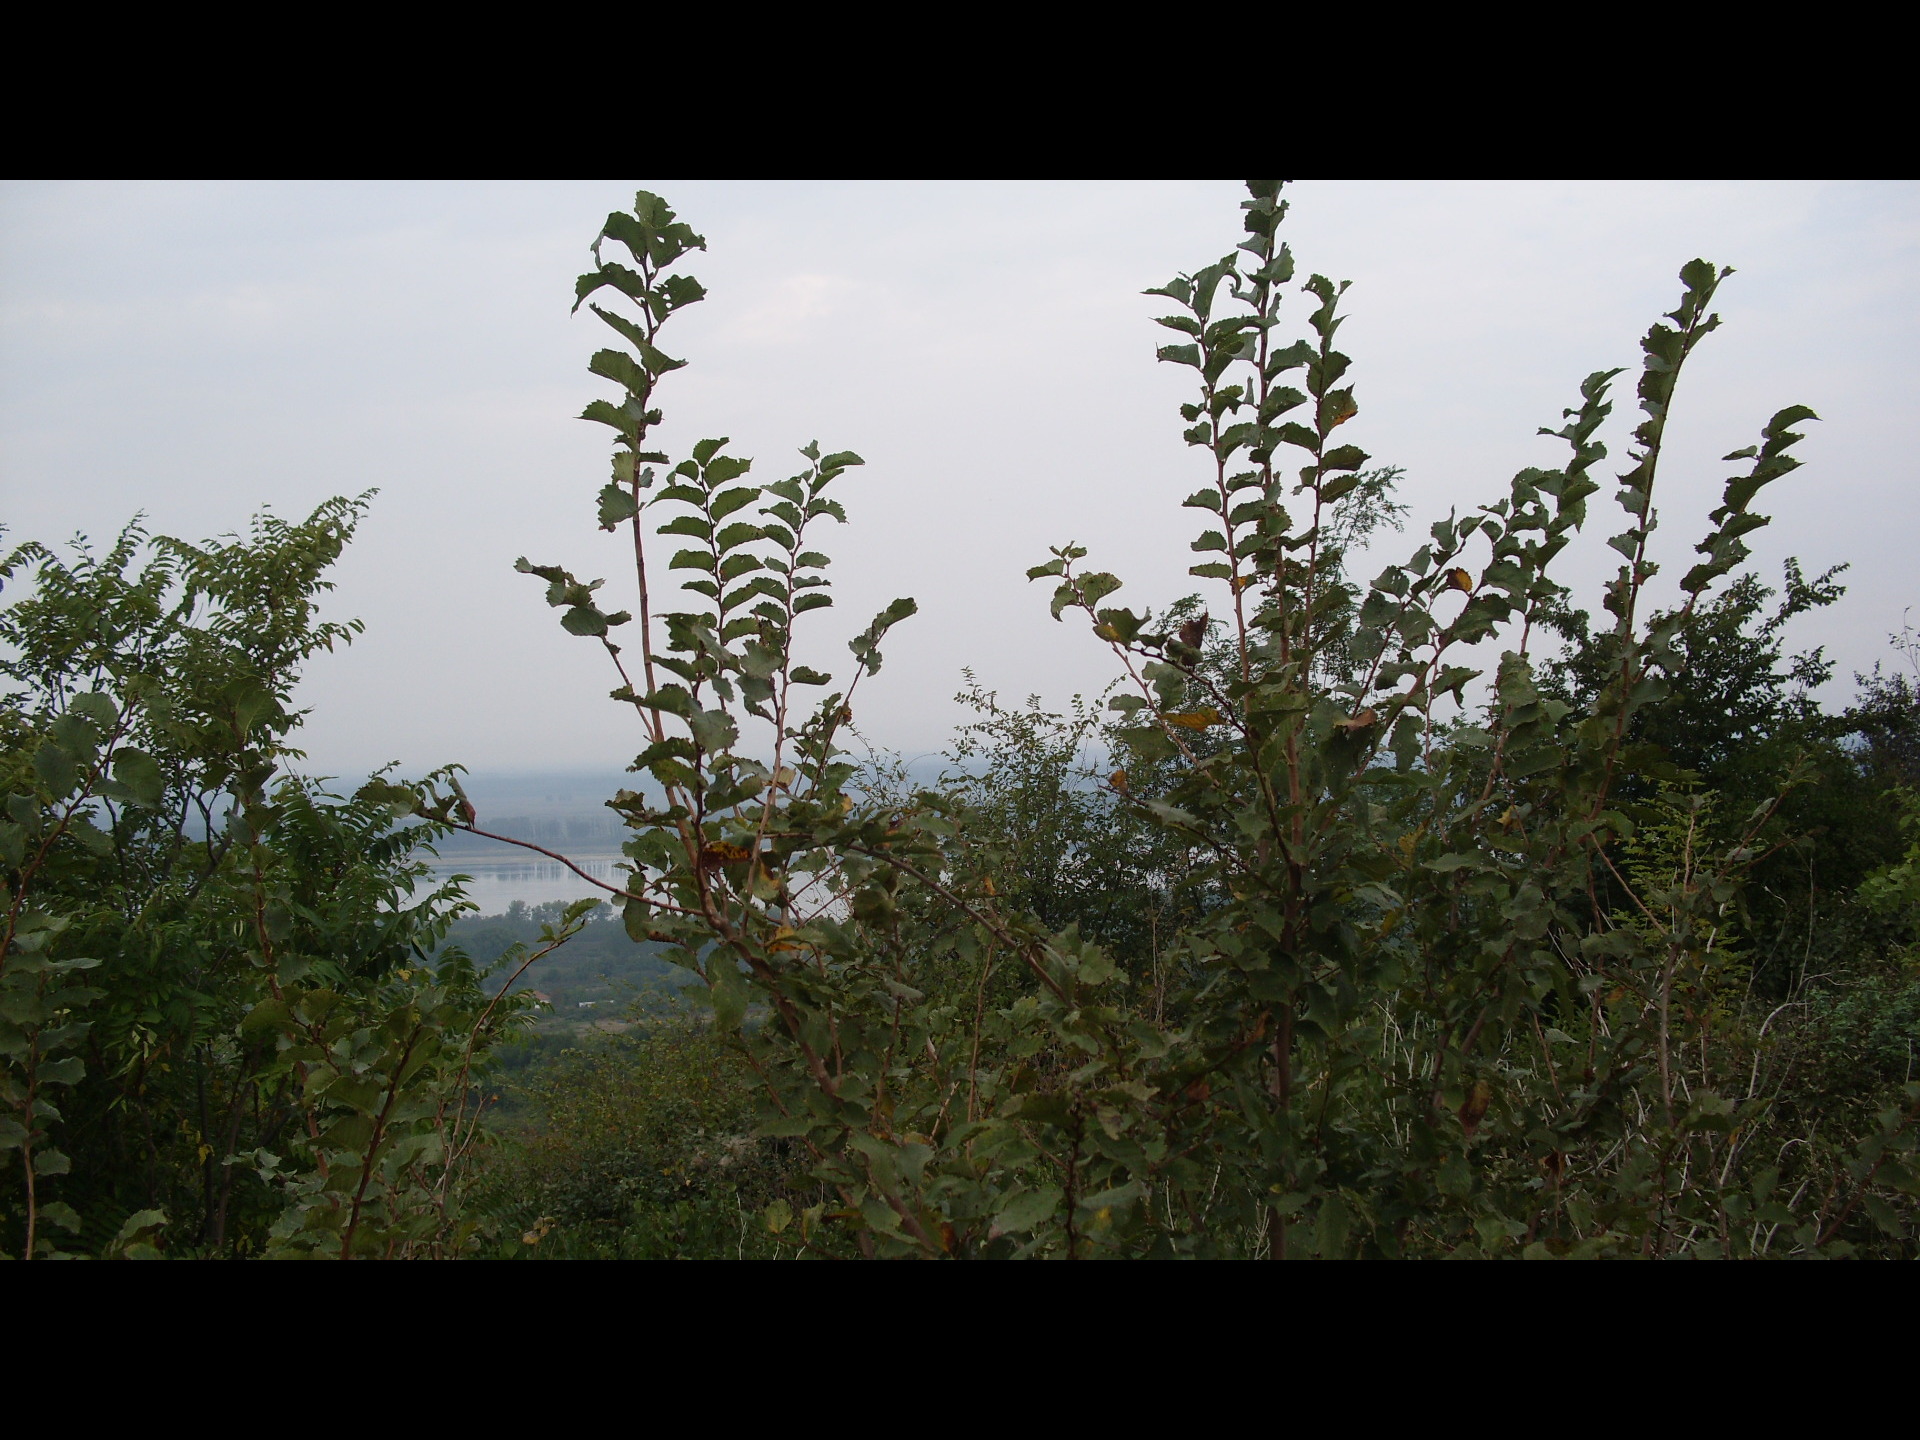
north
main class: Woodland
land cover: Broadleaved woodland
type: mesophytic deciduous forest
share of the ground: > 75 %
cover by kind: broadleaved forest trees 95 %, coniferous forest trees 5 %
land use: Semi-natural and natural areas not in use
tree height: > 5 m
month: September
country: BG
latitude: 43.7865
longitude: 23.1265
